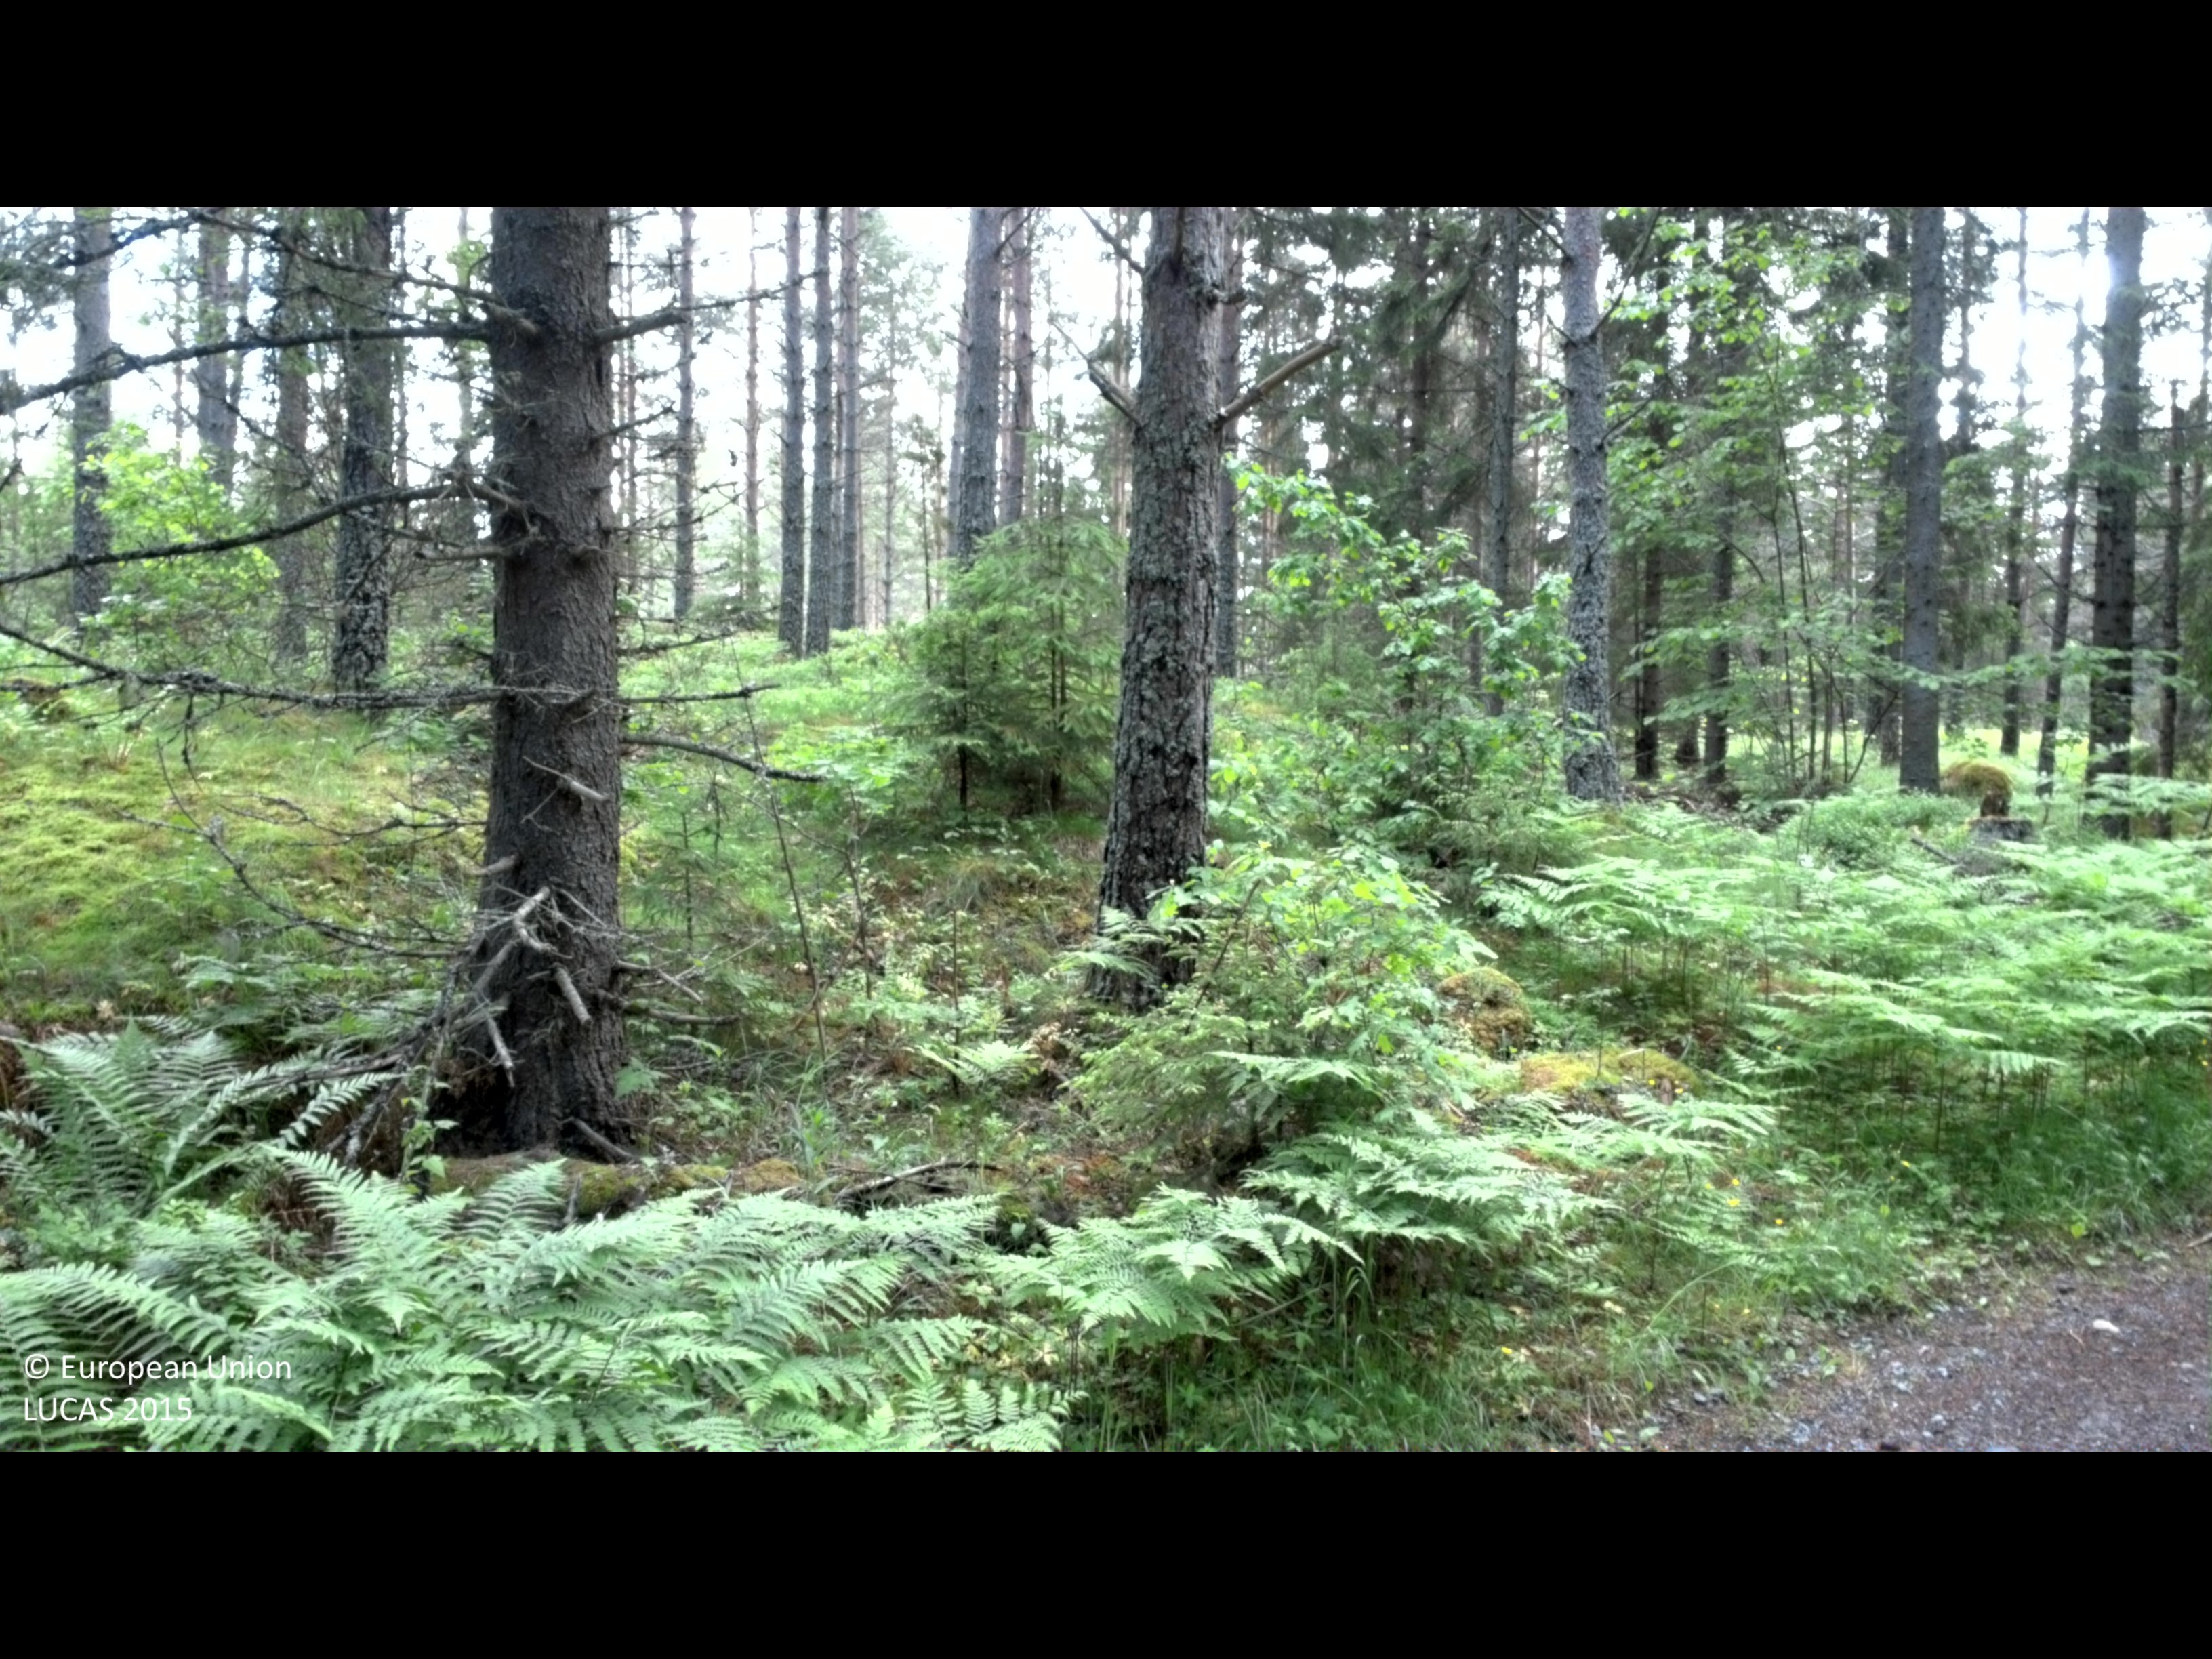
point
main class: Woodland
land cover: Spruce dominated coniferous woodland
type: boreal forest
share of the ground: > 75 %
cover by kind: coniferous forest trees 75 %, shrubs 10 %, lichens and mosses 10 %, broadleaved forest trees 5 %
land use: Forestry
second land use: Sport
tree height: > 5 m
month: June
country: SE
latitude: 58.0818
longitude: 16.0843
